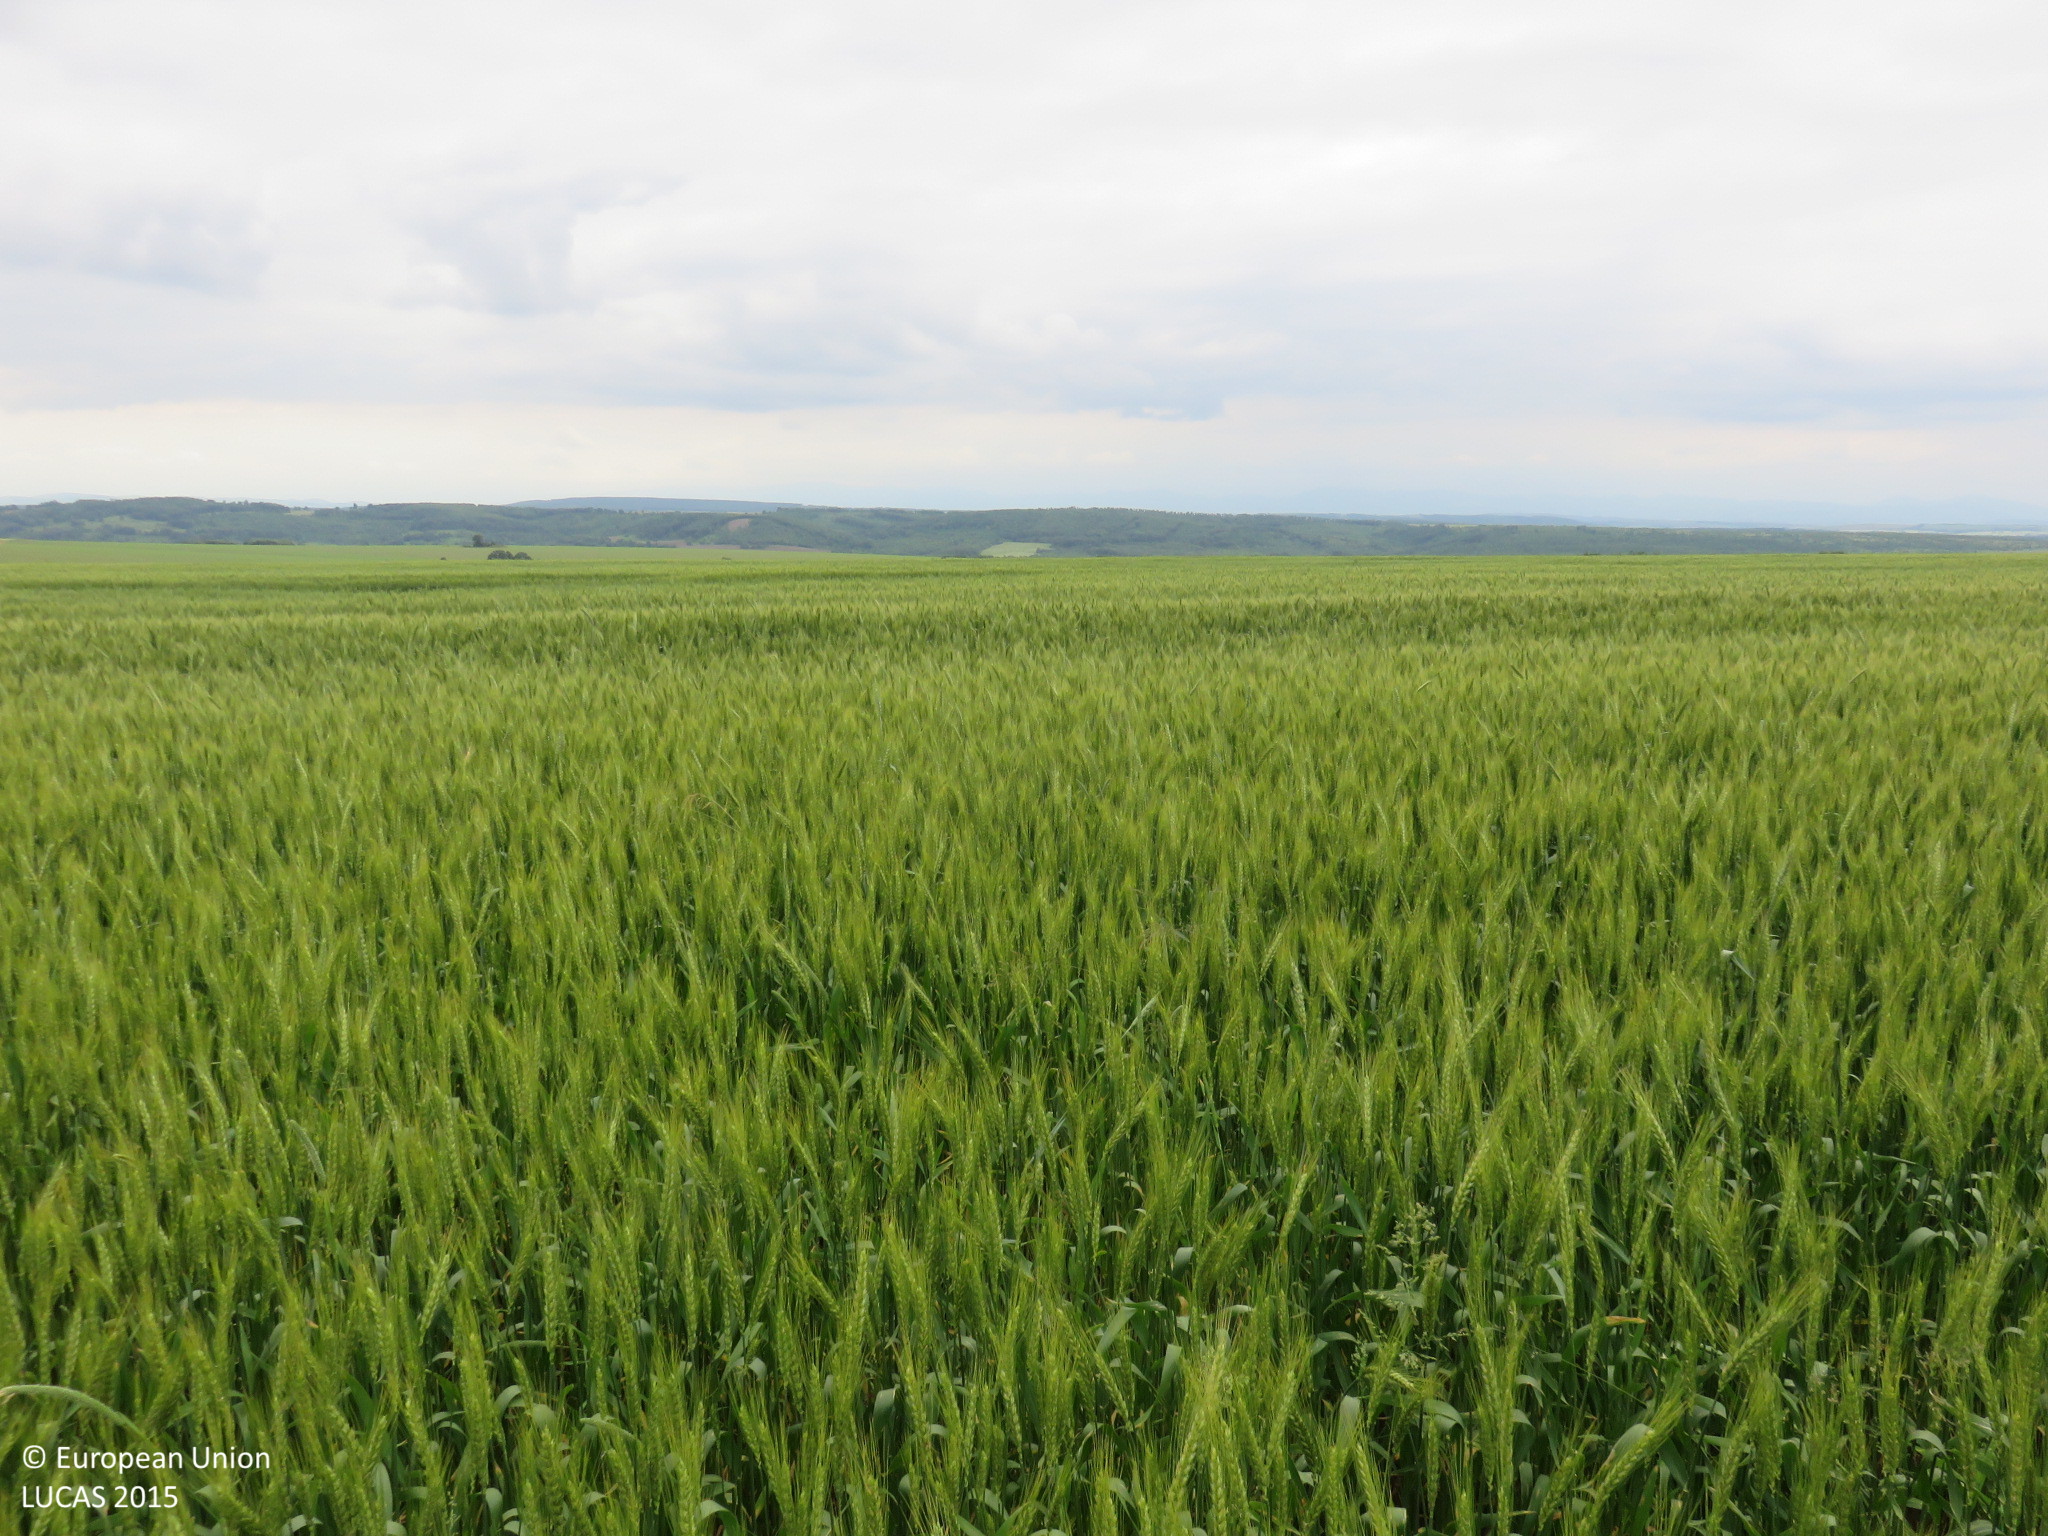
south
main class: Shrubland
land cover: Shrubland without tree cover
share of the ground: > 75 %
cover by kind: shrubs 100 %
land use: Semi-natural and natural areas not in use
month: May
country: BG
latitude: 43.2408
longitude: 24.4543
